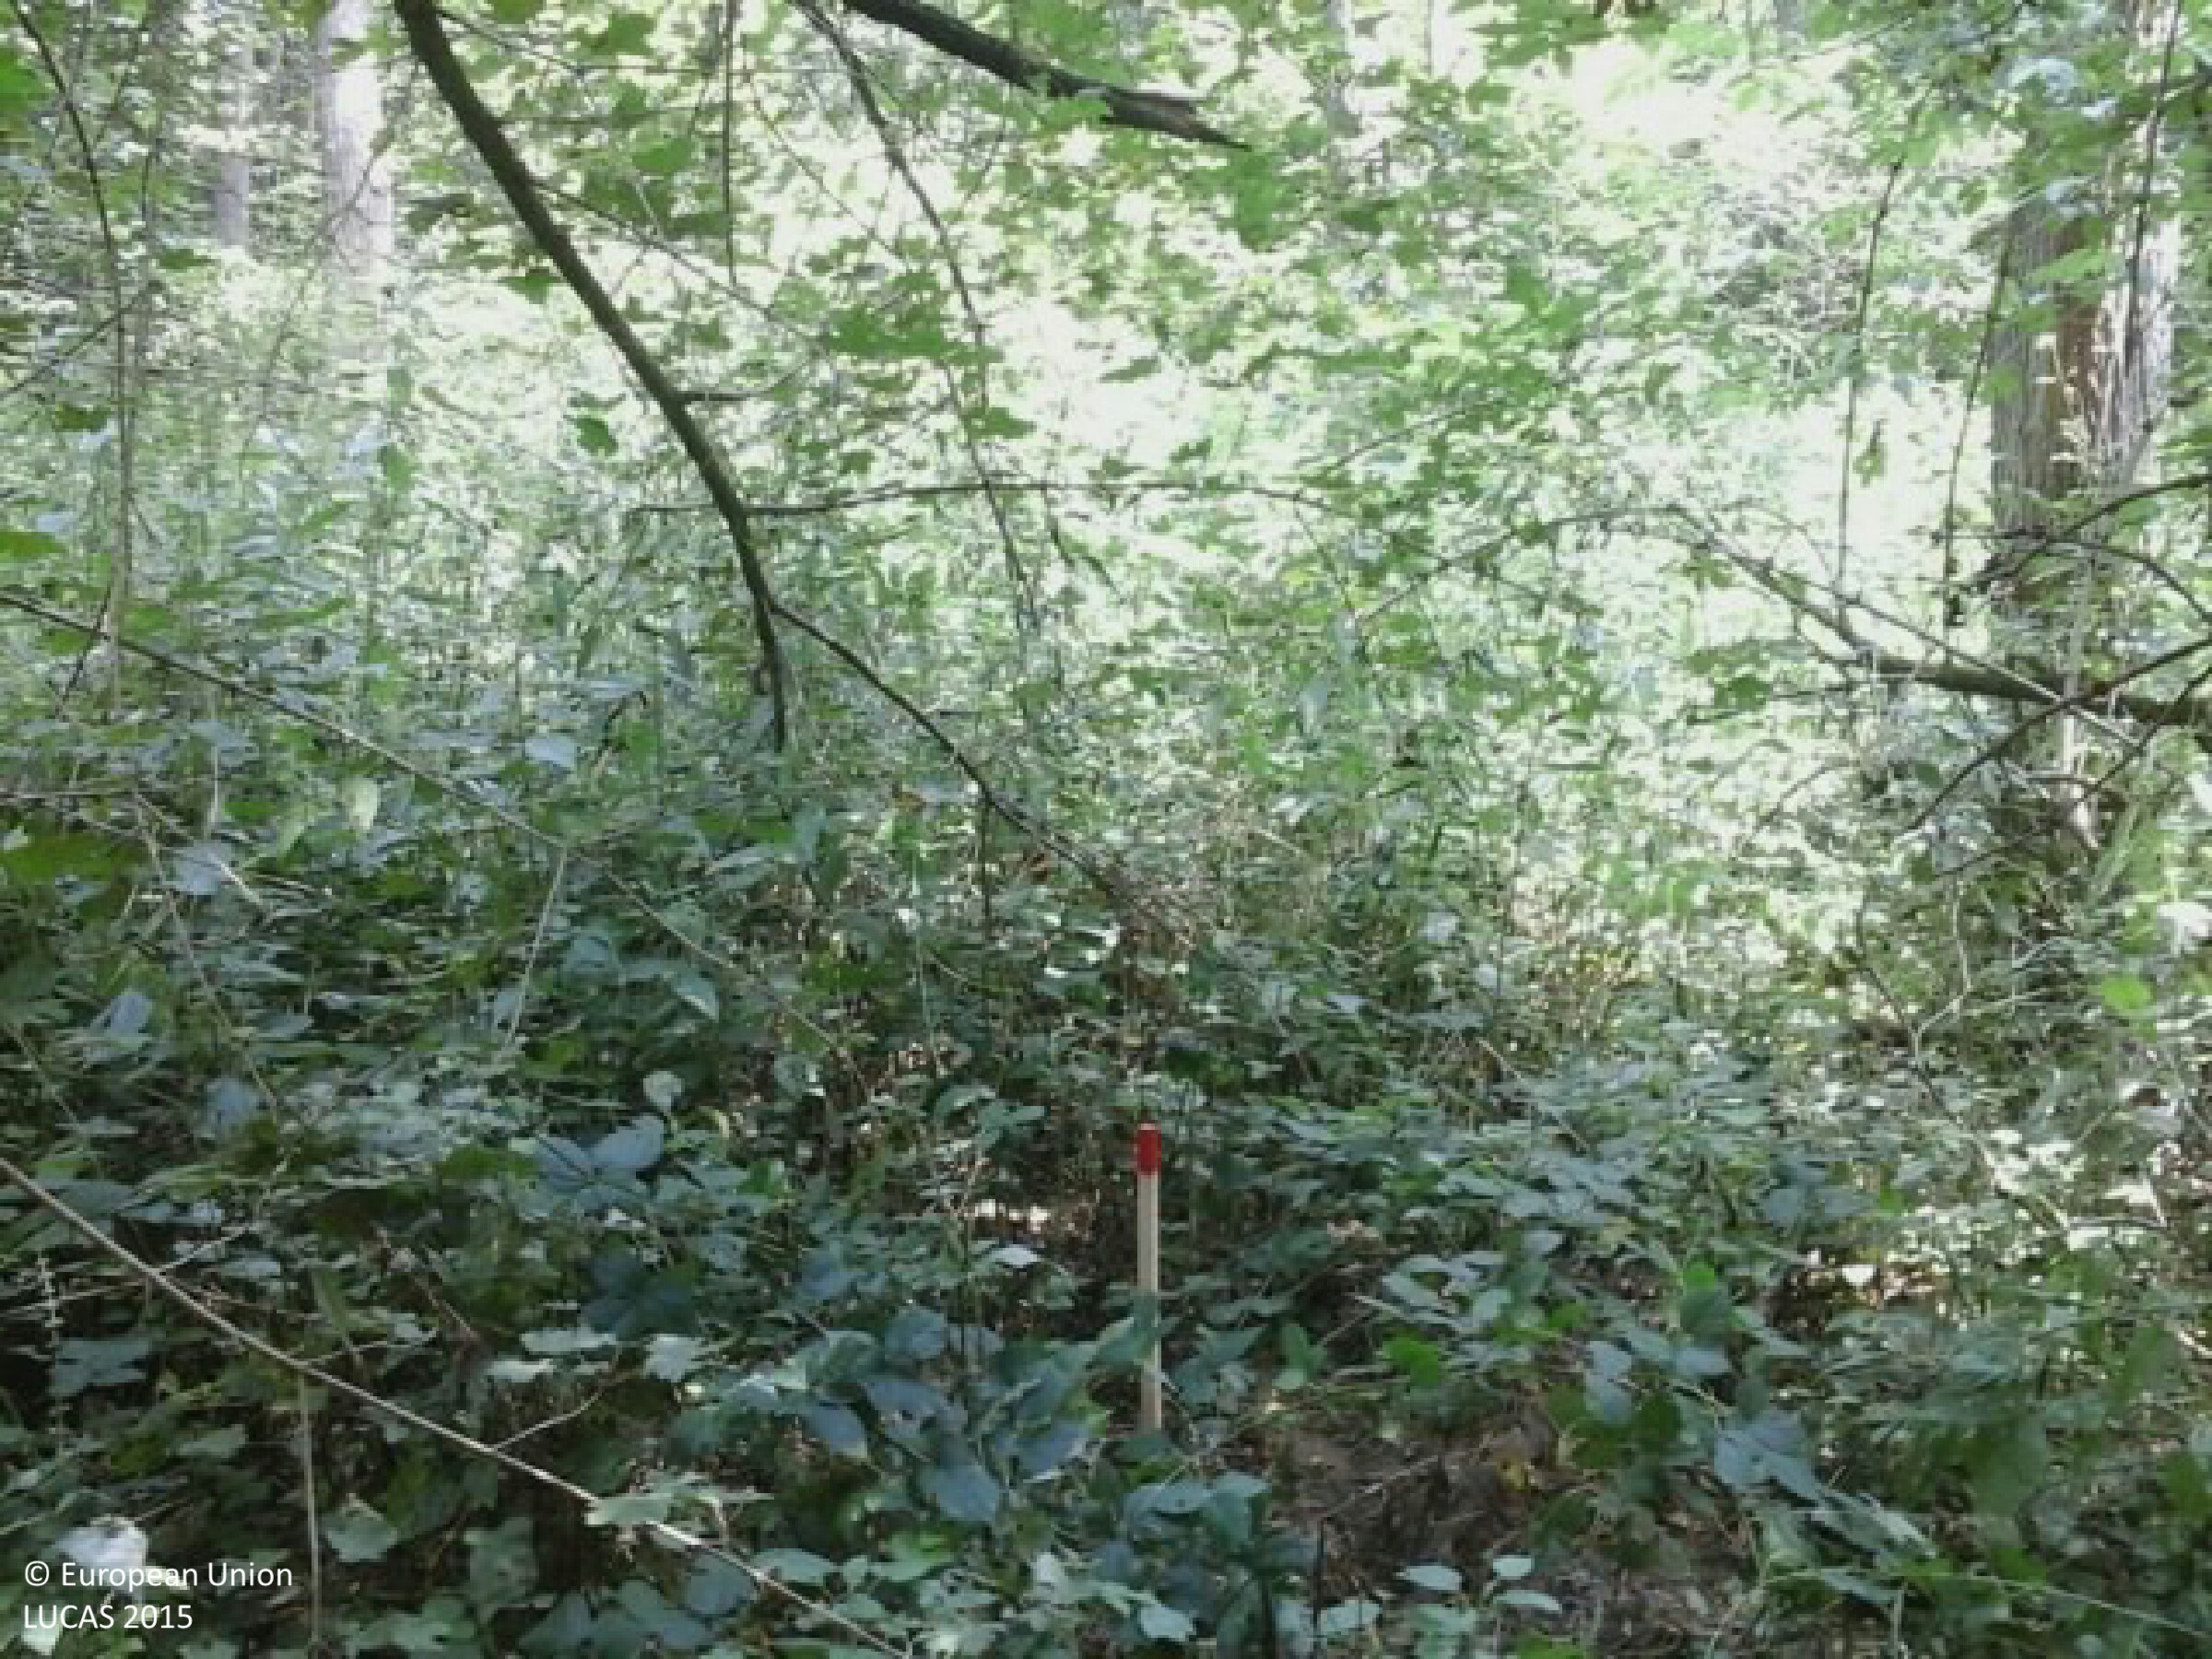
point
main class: Woodland
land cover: Broadleaved woodland
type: mesophytic deciduous forest
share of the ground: > 75 %
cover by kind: broadleaved forest trees 90 %, shrubs 5 %, herbaceous plants 5 %
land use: Forestry
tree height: > 5 m
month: July
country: HU
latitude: 46.3187
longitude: 17.0285
